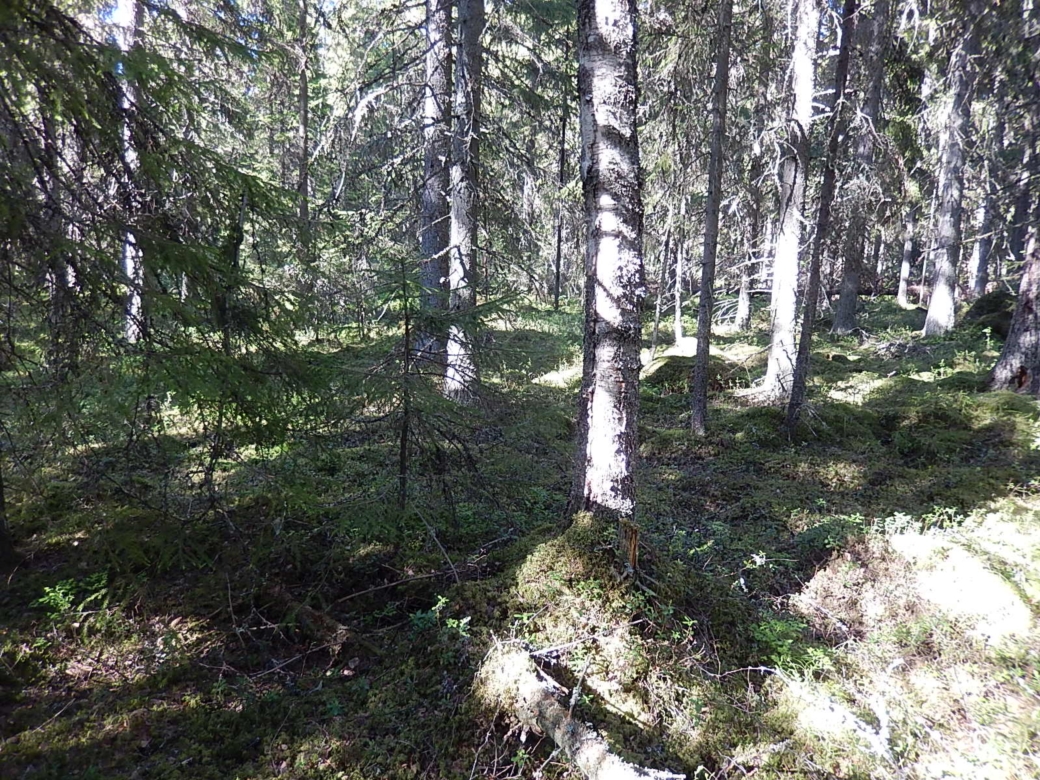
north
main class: Woodland
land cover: Spruce dominated coniferous woodland
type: boreal forest
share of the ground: > 75 %
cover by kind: coniferous forest trees 80 %, shrubs 10 %, lichens and mosses 10 %
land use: Forestry
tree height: > 5 m
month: June
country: FI
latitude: 61.9539
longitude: 21.4669
